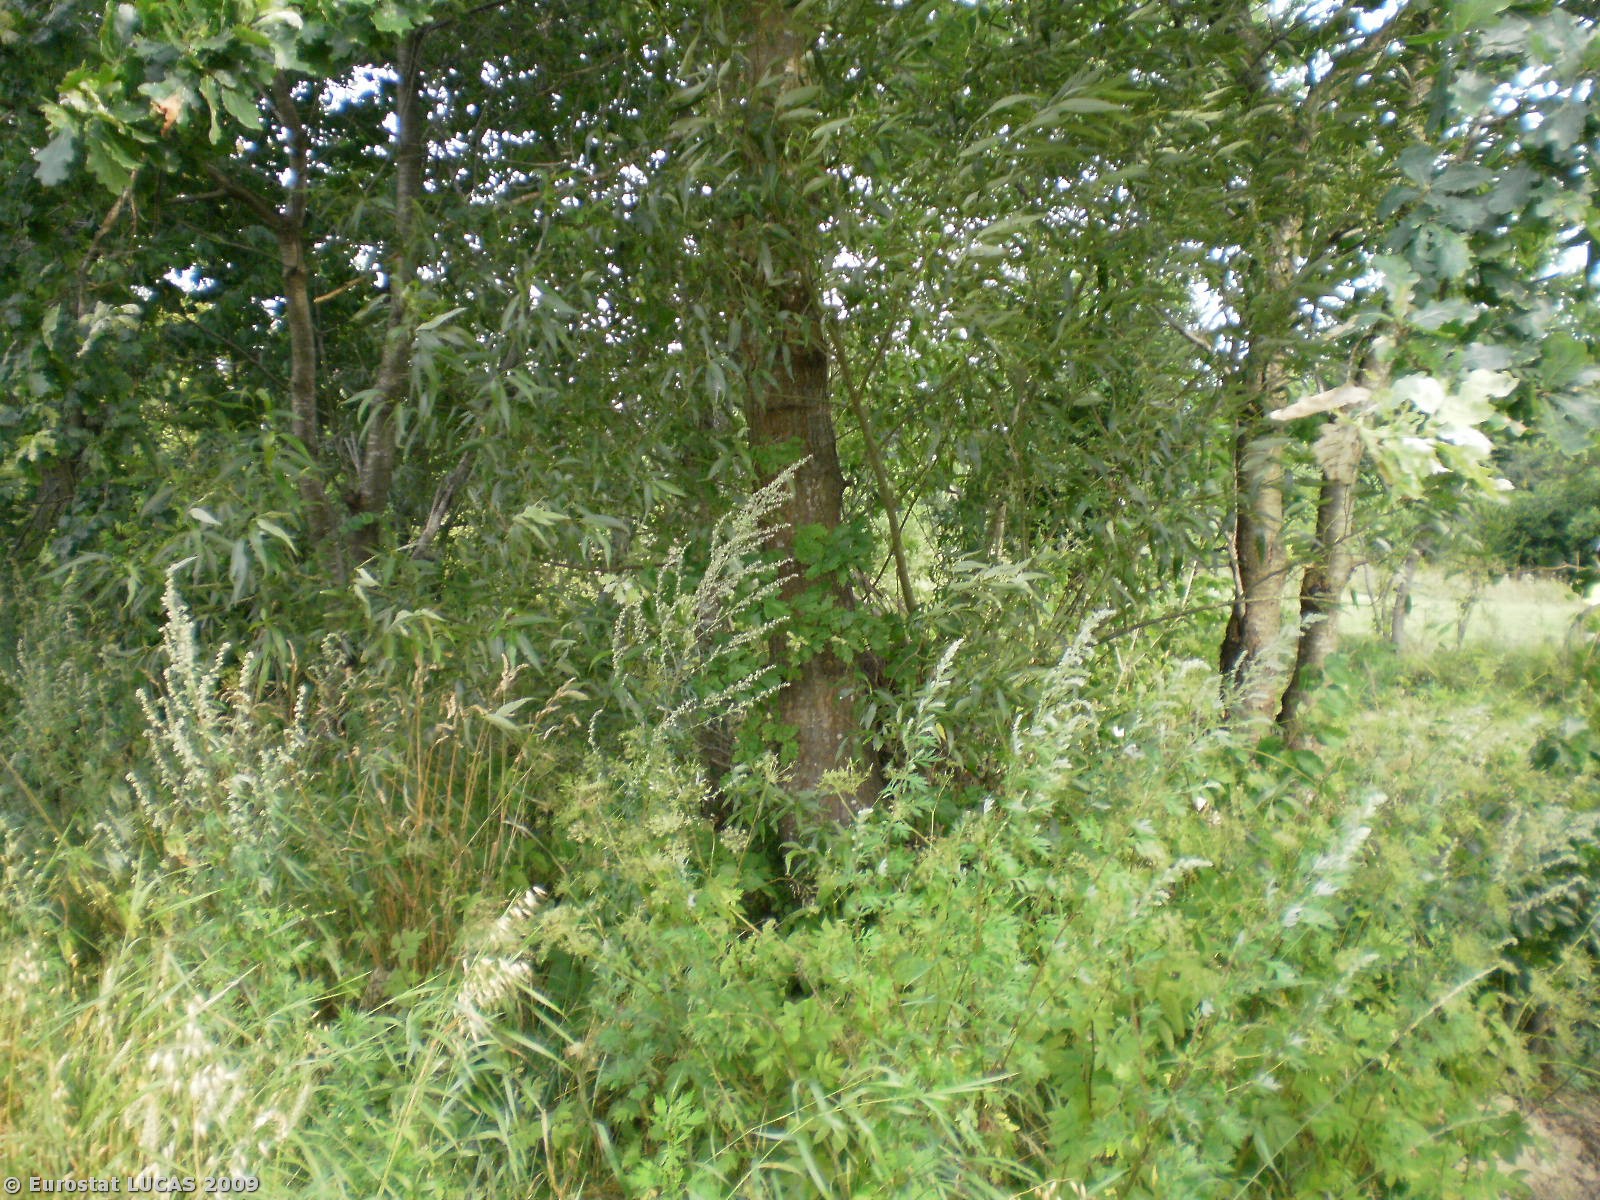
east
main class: Cropland
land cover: Mixed cereals for fodder
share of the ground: > 75 %
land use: Agriculture (excluding fallow land and kitchen gardens)
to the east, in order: Mixed cereals for fodder; Shrubland with sparse tree cover; Tracks; Grass margins; Abandoned hedges; Grassland without tree/shrub cover; Shrubland with sparse tree cover; Grassland without tree/shrub cover
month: August
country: PL
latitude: 54.2651
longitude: 19.6537
